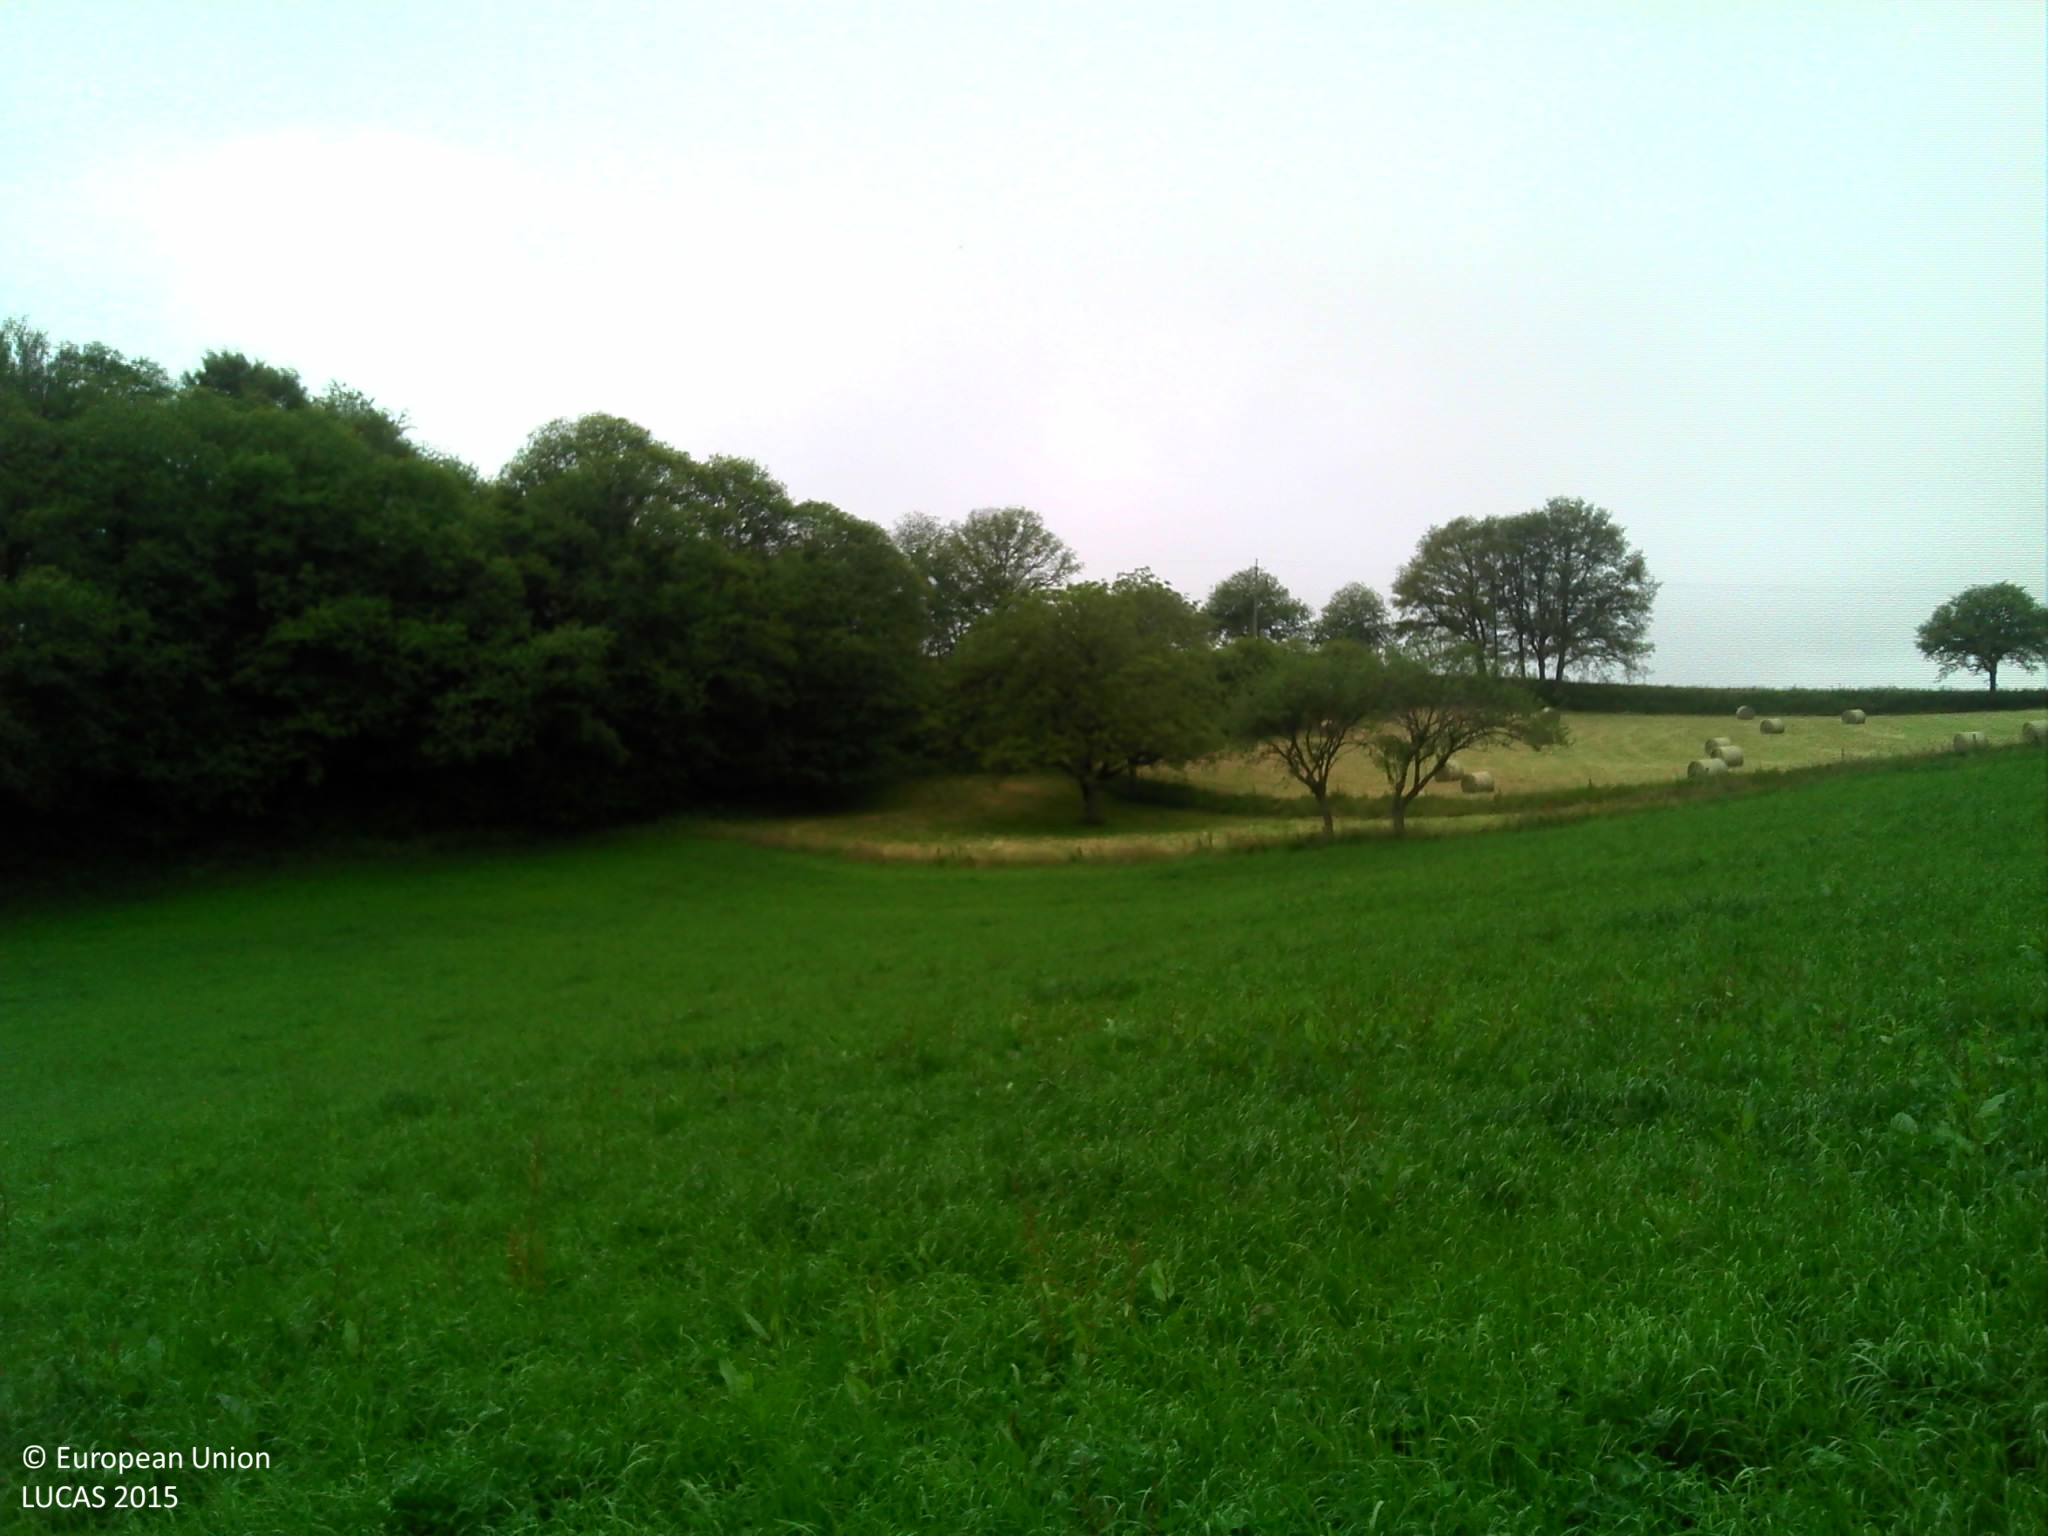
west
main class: Cropland
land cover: Temporary grasslands
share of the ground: > 75 %
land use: Agriculture (excluding fallow land and kitchen gardens)
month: June
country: FR
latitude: 44.7283
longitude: 1.9817
